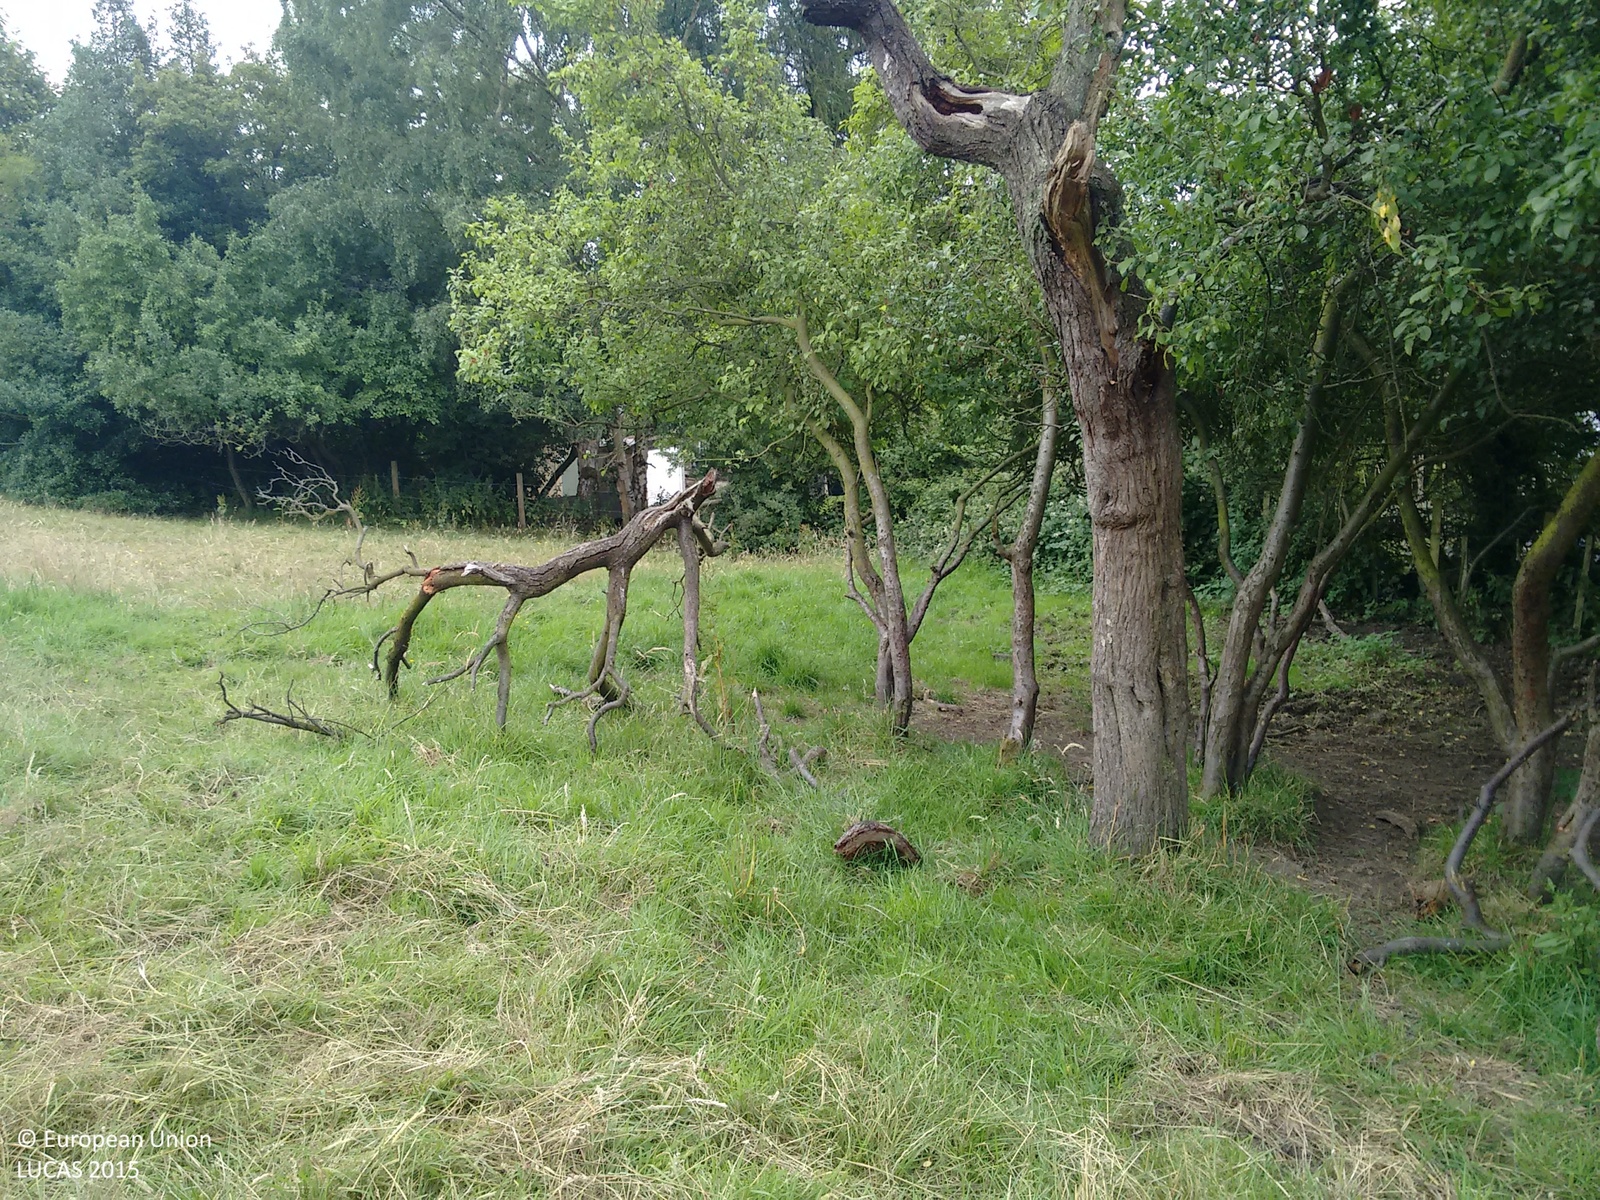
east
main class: Grassland
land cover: Grassland without tree/shrub cover
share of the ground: > 75 %
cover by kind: herbaceous plants 100 %
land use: Agriculture (excluding fallow land and kitchen gardens)
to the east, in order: Grassland without tree/shrub cover; Fences; Grass margins; Artificial constructions in urban areas; Grassland without tree/shrub cover; Electric lines; Grassland without tree/shrub cover; Fences; Grassland without tree/shrub cover
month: July
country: GB
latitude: 53.0730
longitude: -1.4683
